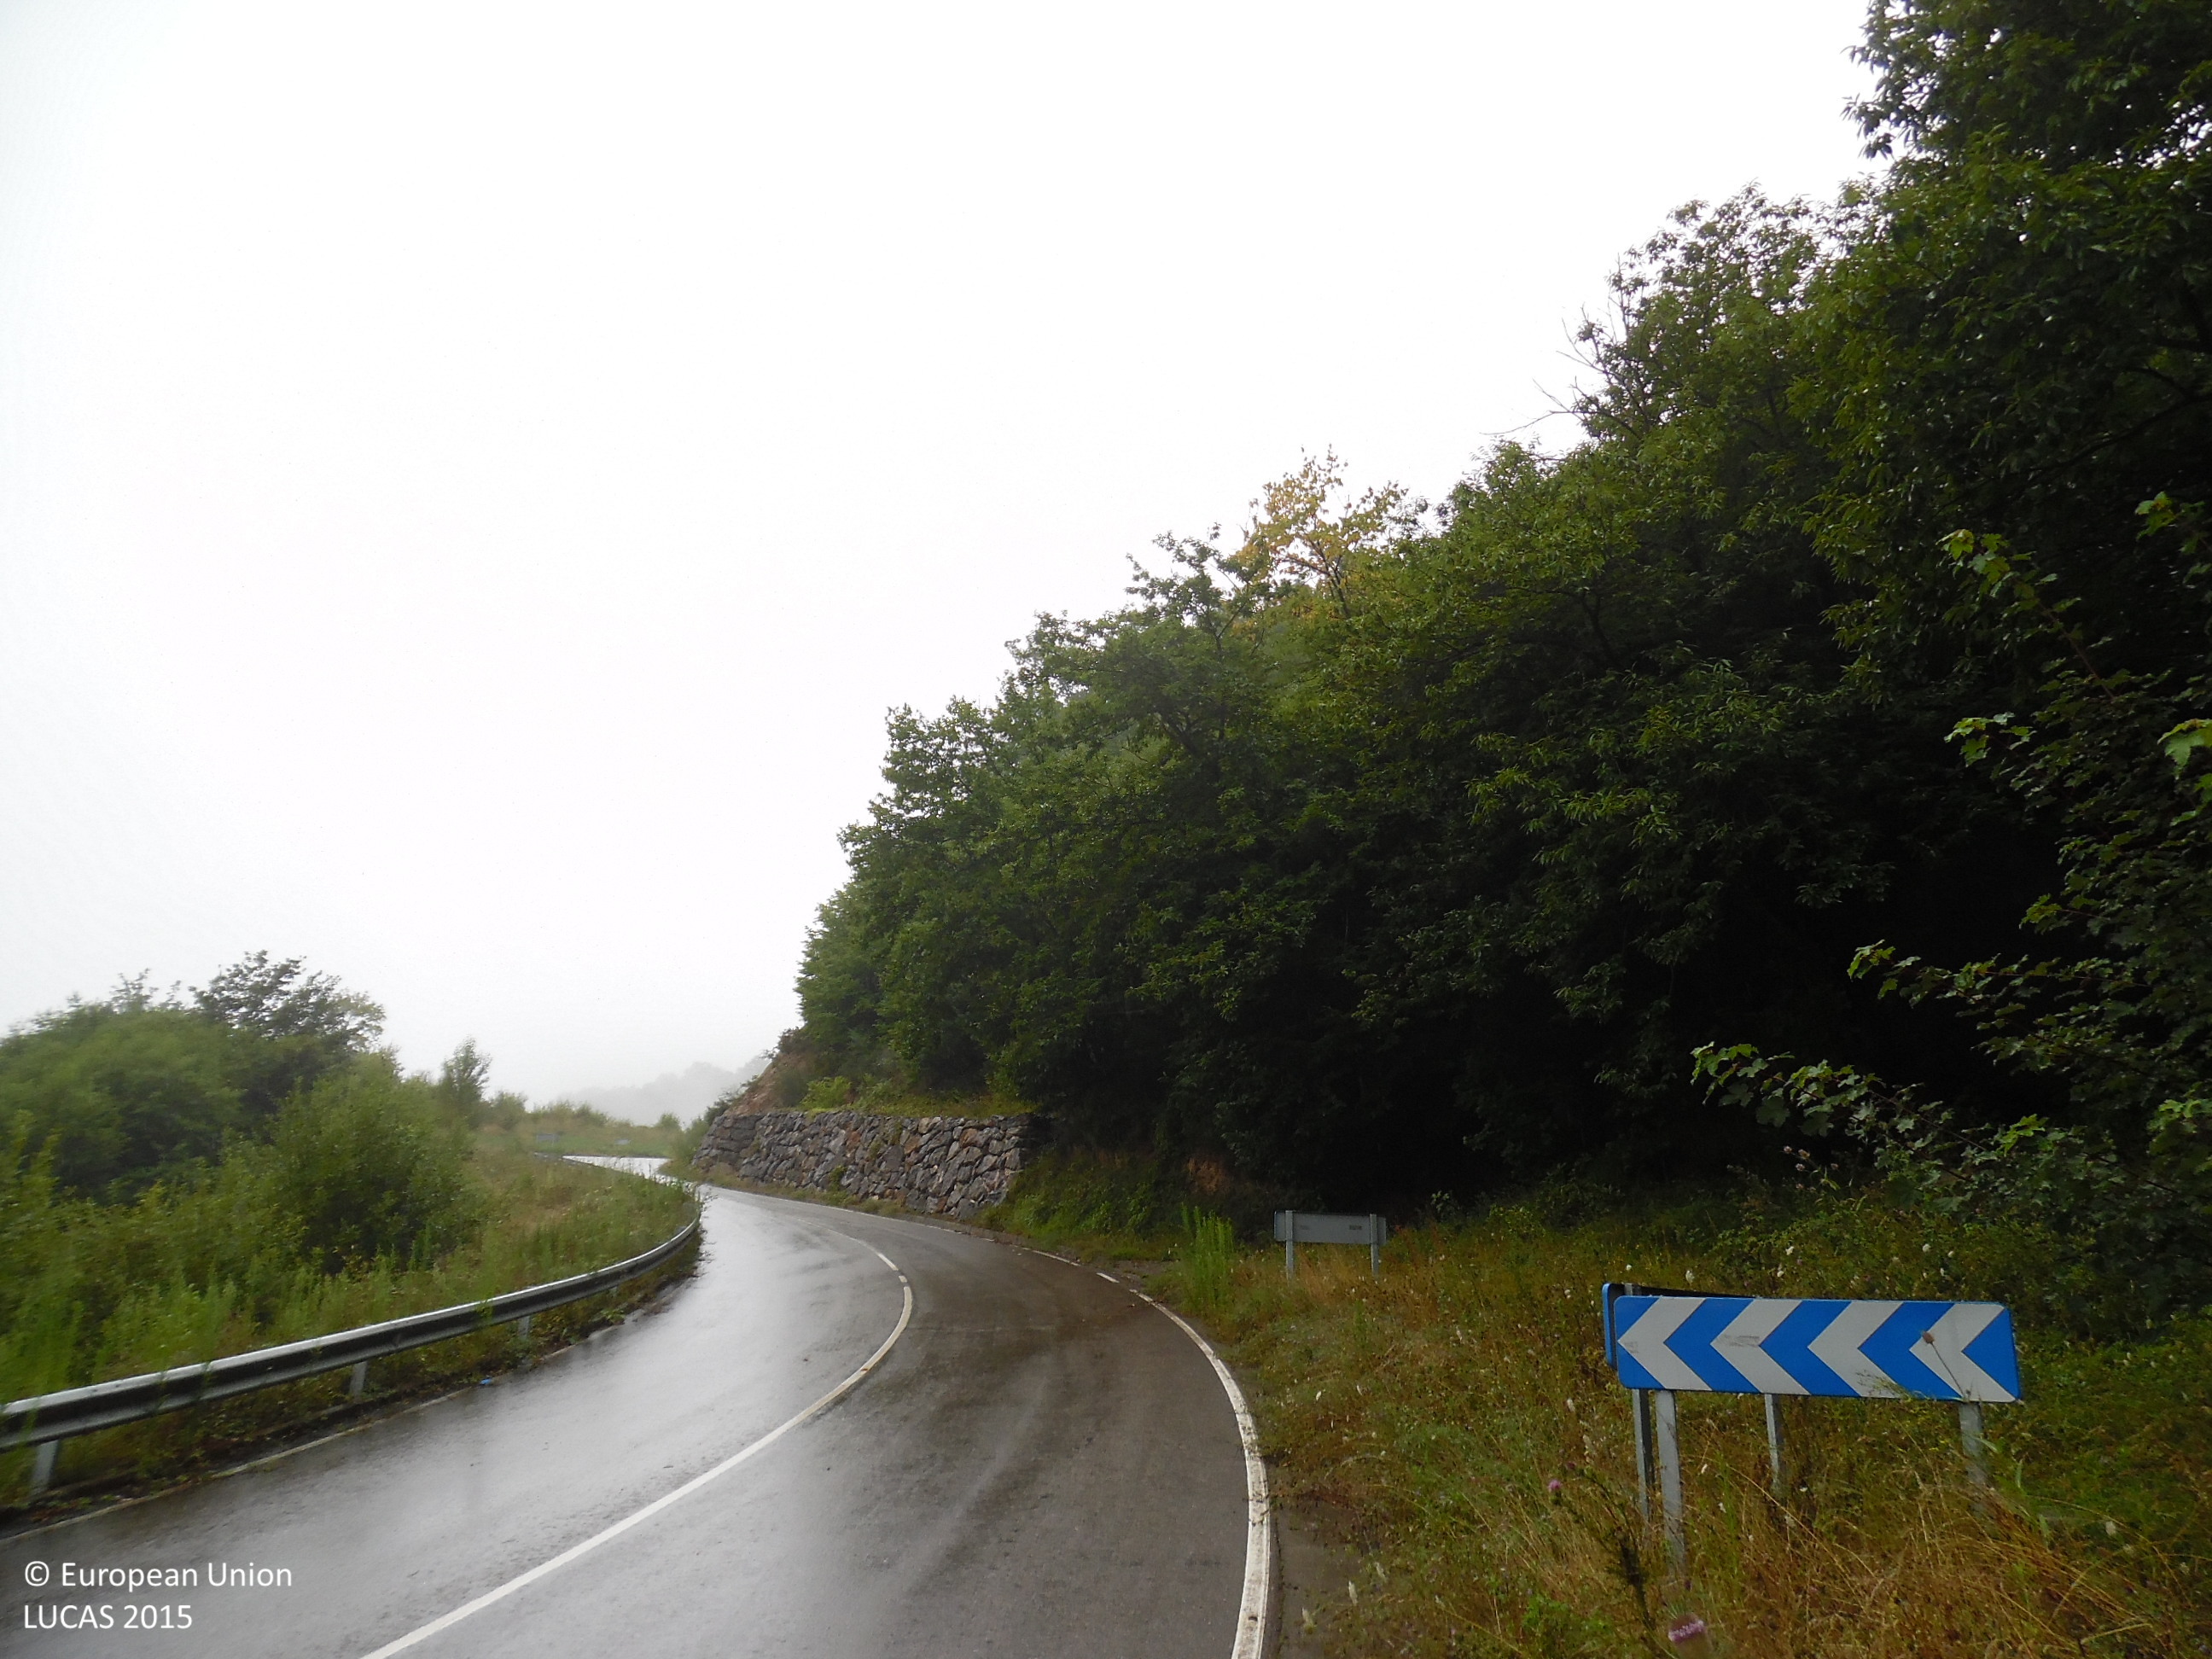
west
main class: Woodland
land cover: Broadleaved woodland
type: thermophilous deciduous forest
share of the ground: > 75 %
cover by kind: broadleaved forest trees 100 %
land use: Forestry
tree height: > 5 m
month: July
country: ES
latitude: 43.1575
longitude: -5.8643
